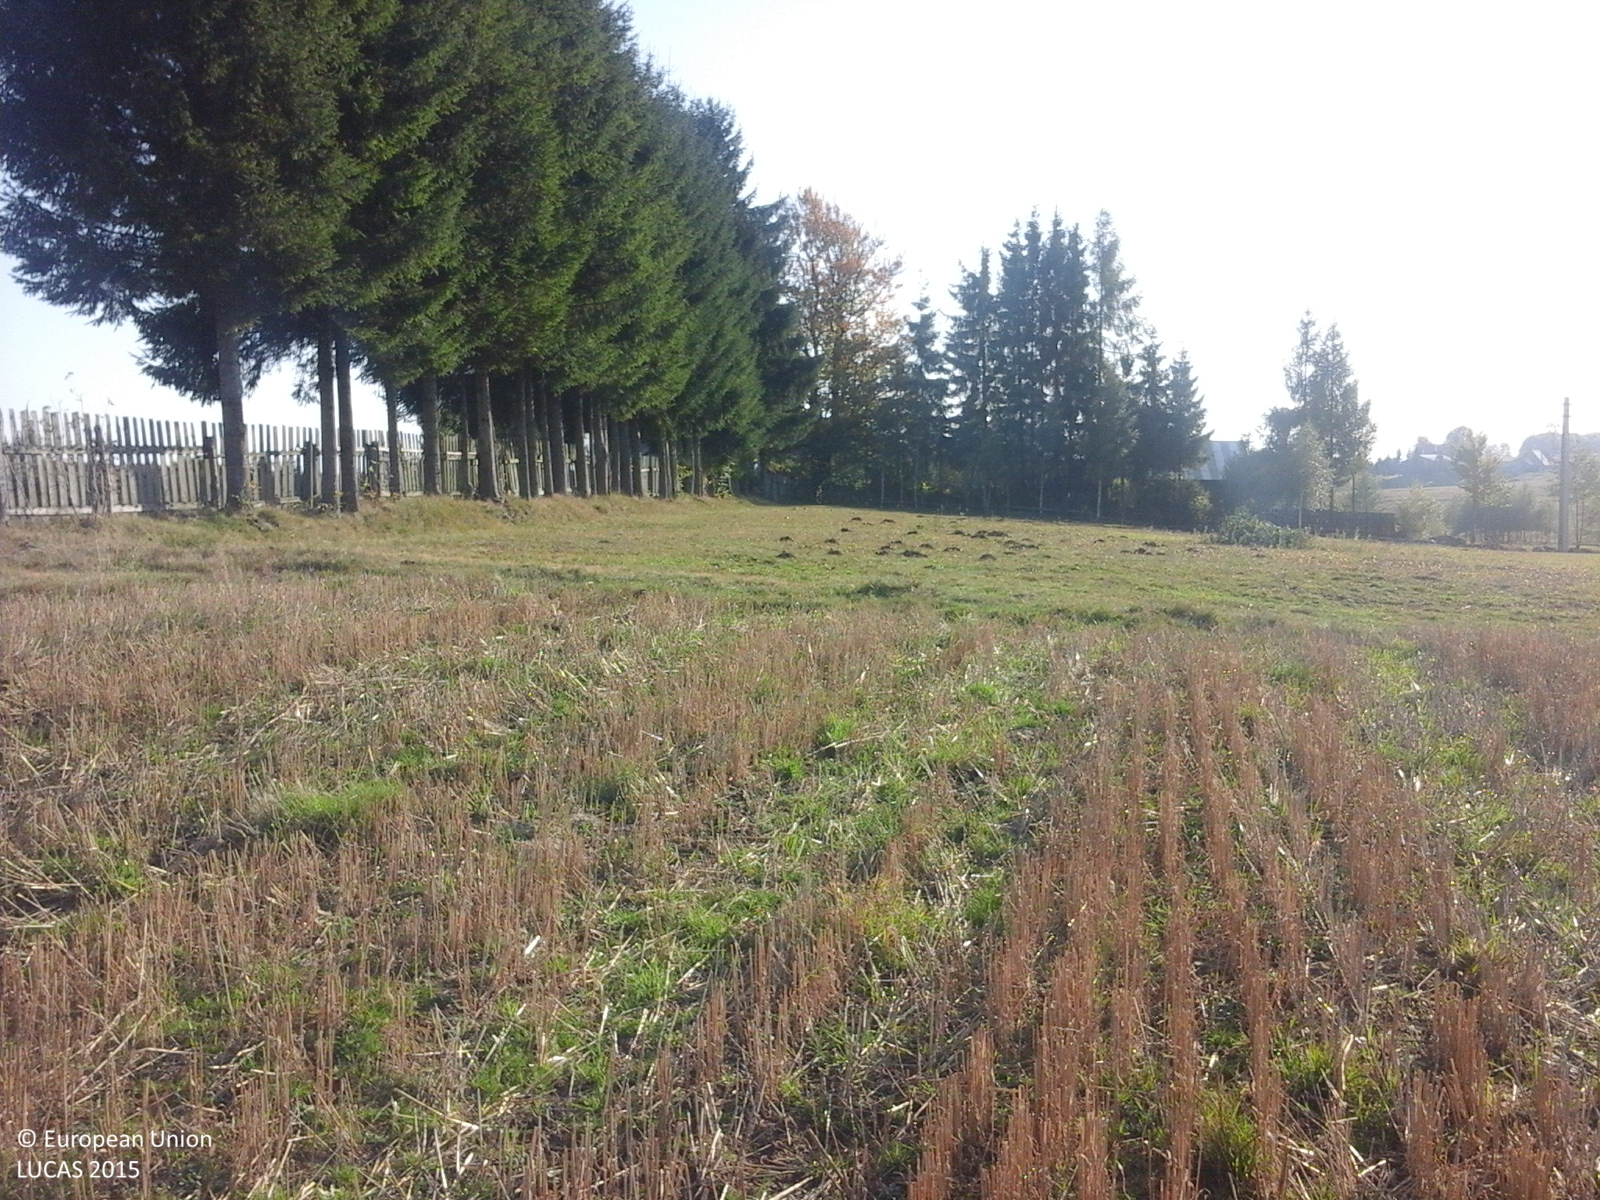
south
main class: Cropland
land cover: Barley
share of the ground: > 75 %
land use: Agriculture (excluding fallow land and kitchen gardens)
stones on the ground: < 10 %
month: October
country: RO
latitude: 46.5156
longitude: 25.2353
